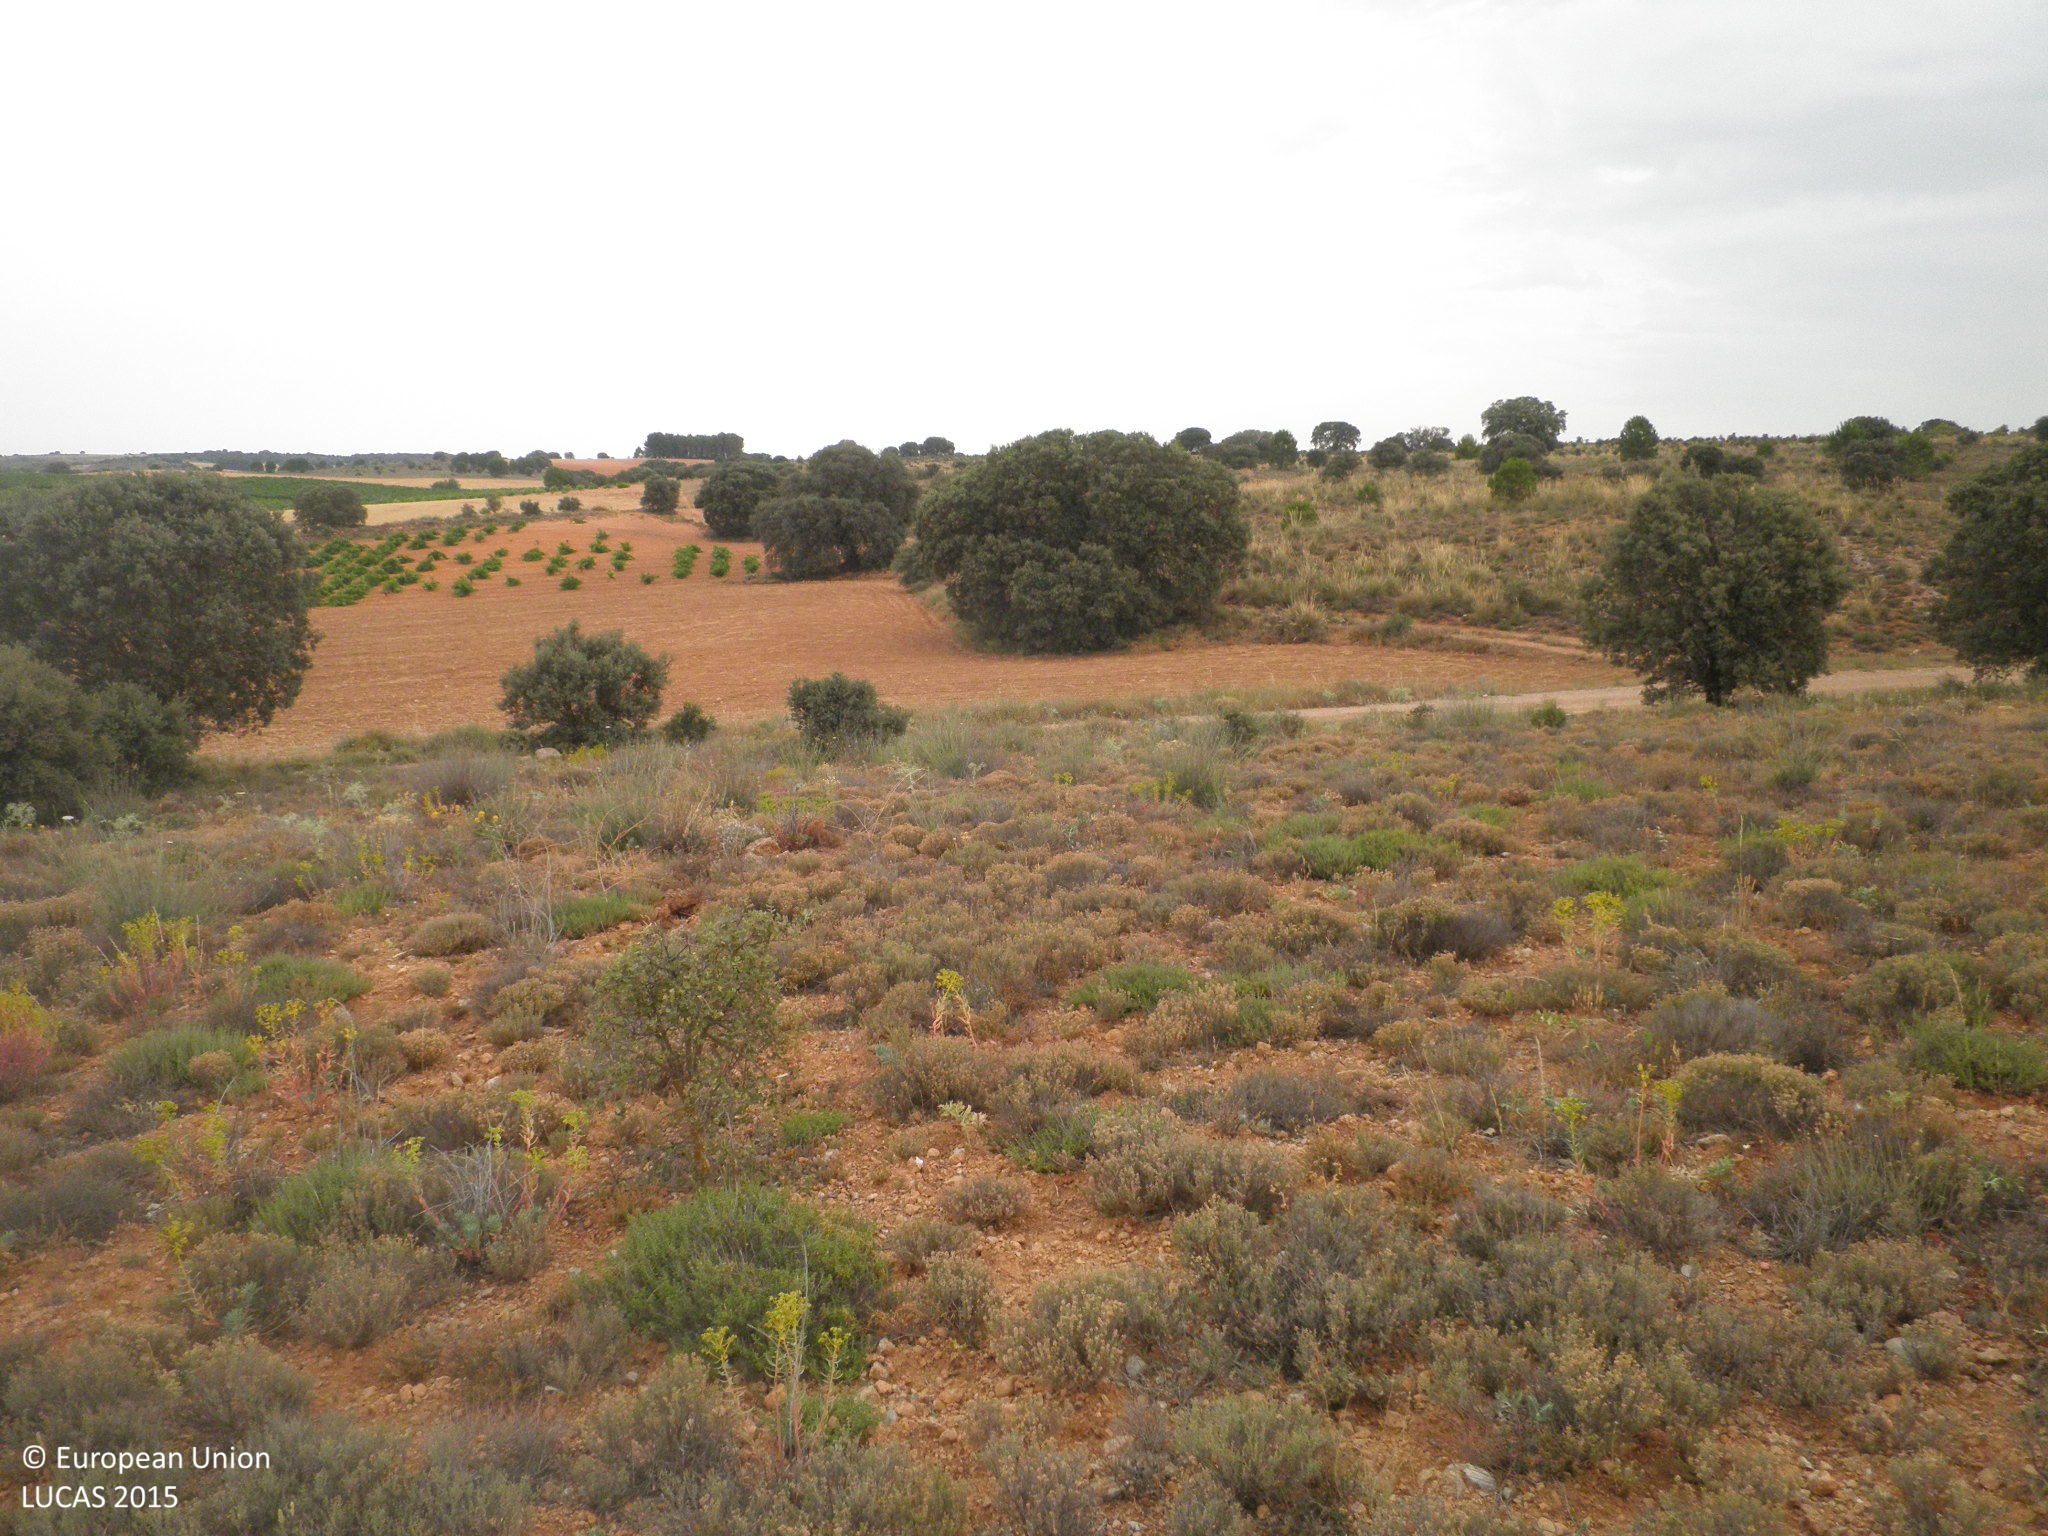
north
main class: Shrubland
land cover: Shrubland without tree cover
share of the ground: 50 - 75 %
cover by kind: shrubs 60 %, unconsolidated bare surface 35 %, herbaceous plants 5 %
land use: Semi-natural and natural areas not in use
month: July
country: ES
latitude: 39.5053
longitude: -2.6083
